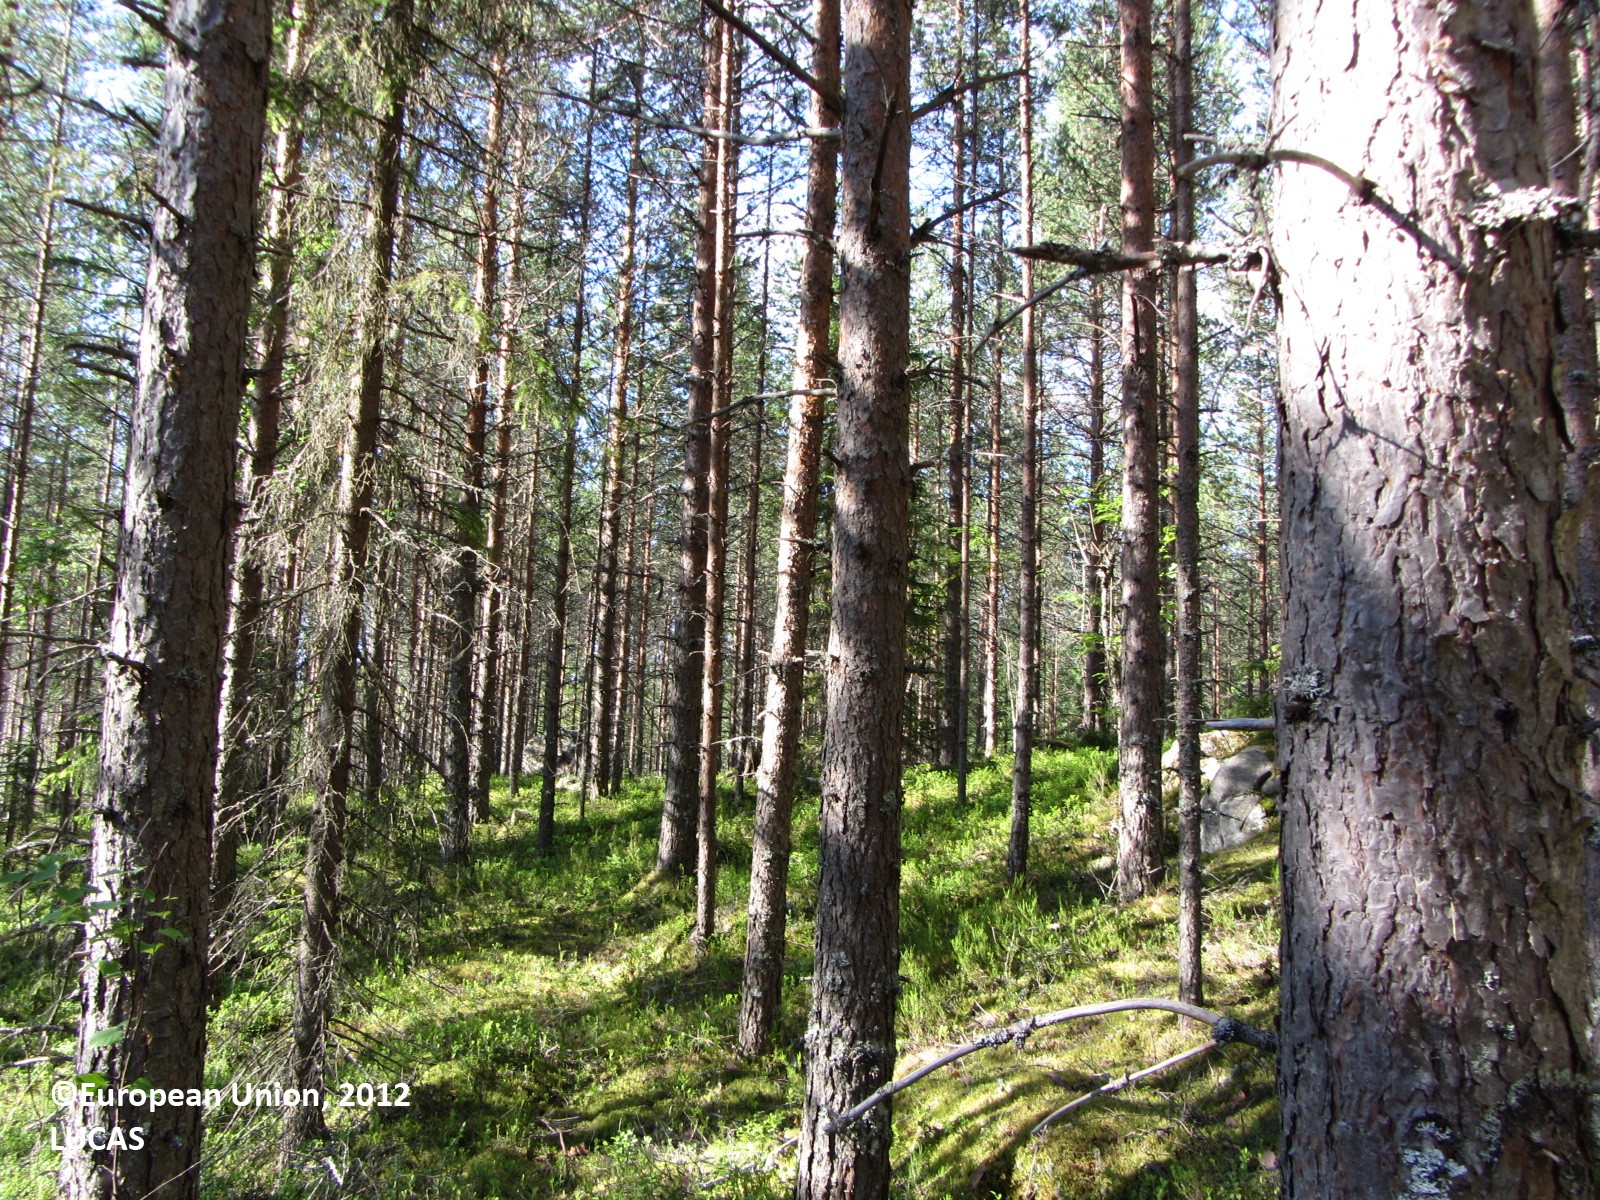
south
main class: Woodland
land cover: Pine dominated coniferous woodland
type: boreal forest
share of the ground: 25 - 50 %
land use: Forestry
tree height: > 5 m
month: July
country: FI
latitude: 62.8142
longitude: 25.3491
